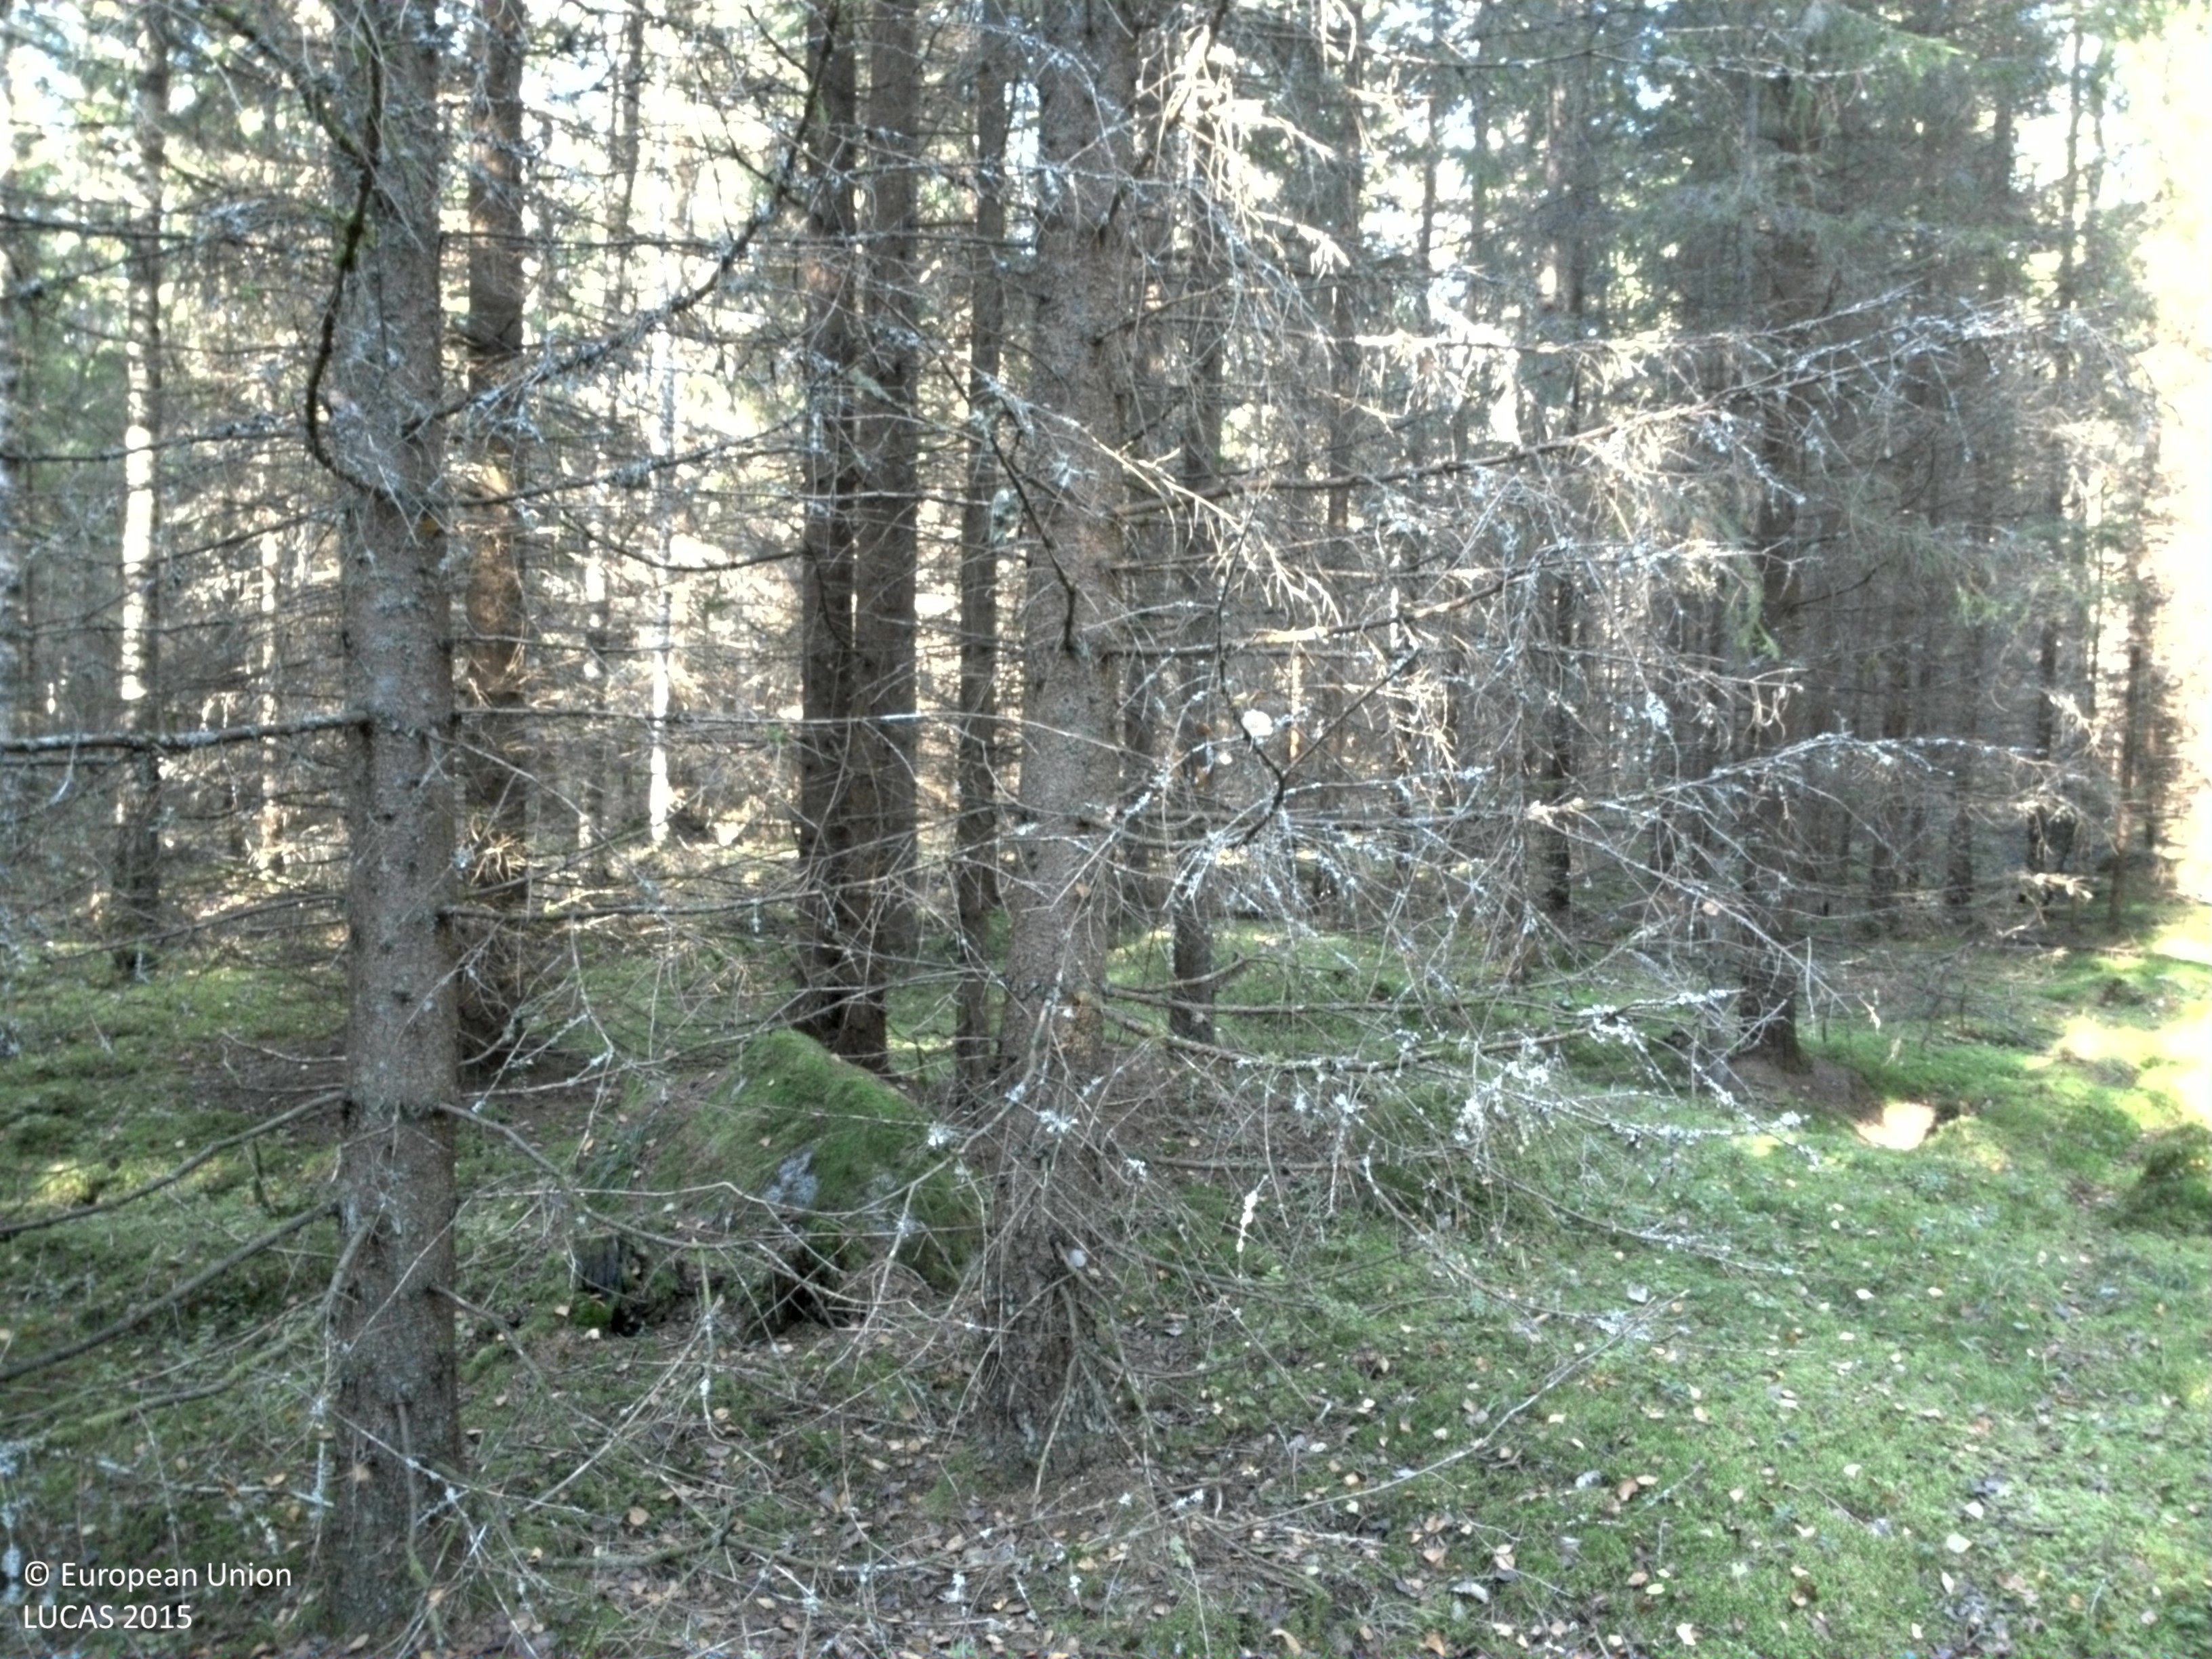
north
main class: Woodland
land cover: Spruce dominated mixed woodland
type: boreal forest
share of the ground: 10 - 25 %
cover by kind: lichens and mosses 65 %, coniferous forest trees 15 %, broadleaved forest trees 10 %, herbaceous plants 10 %
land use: Forestry
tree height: > 5 m
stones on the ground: 10 - 25 %
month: September
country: SE
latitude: 59.0950
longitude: 14.0594
